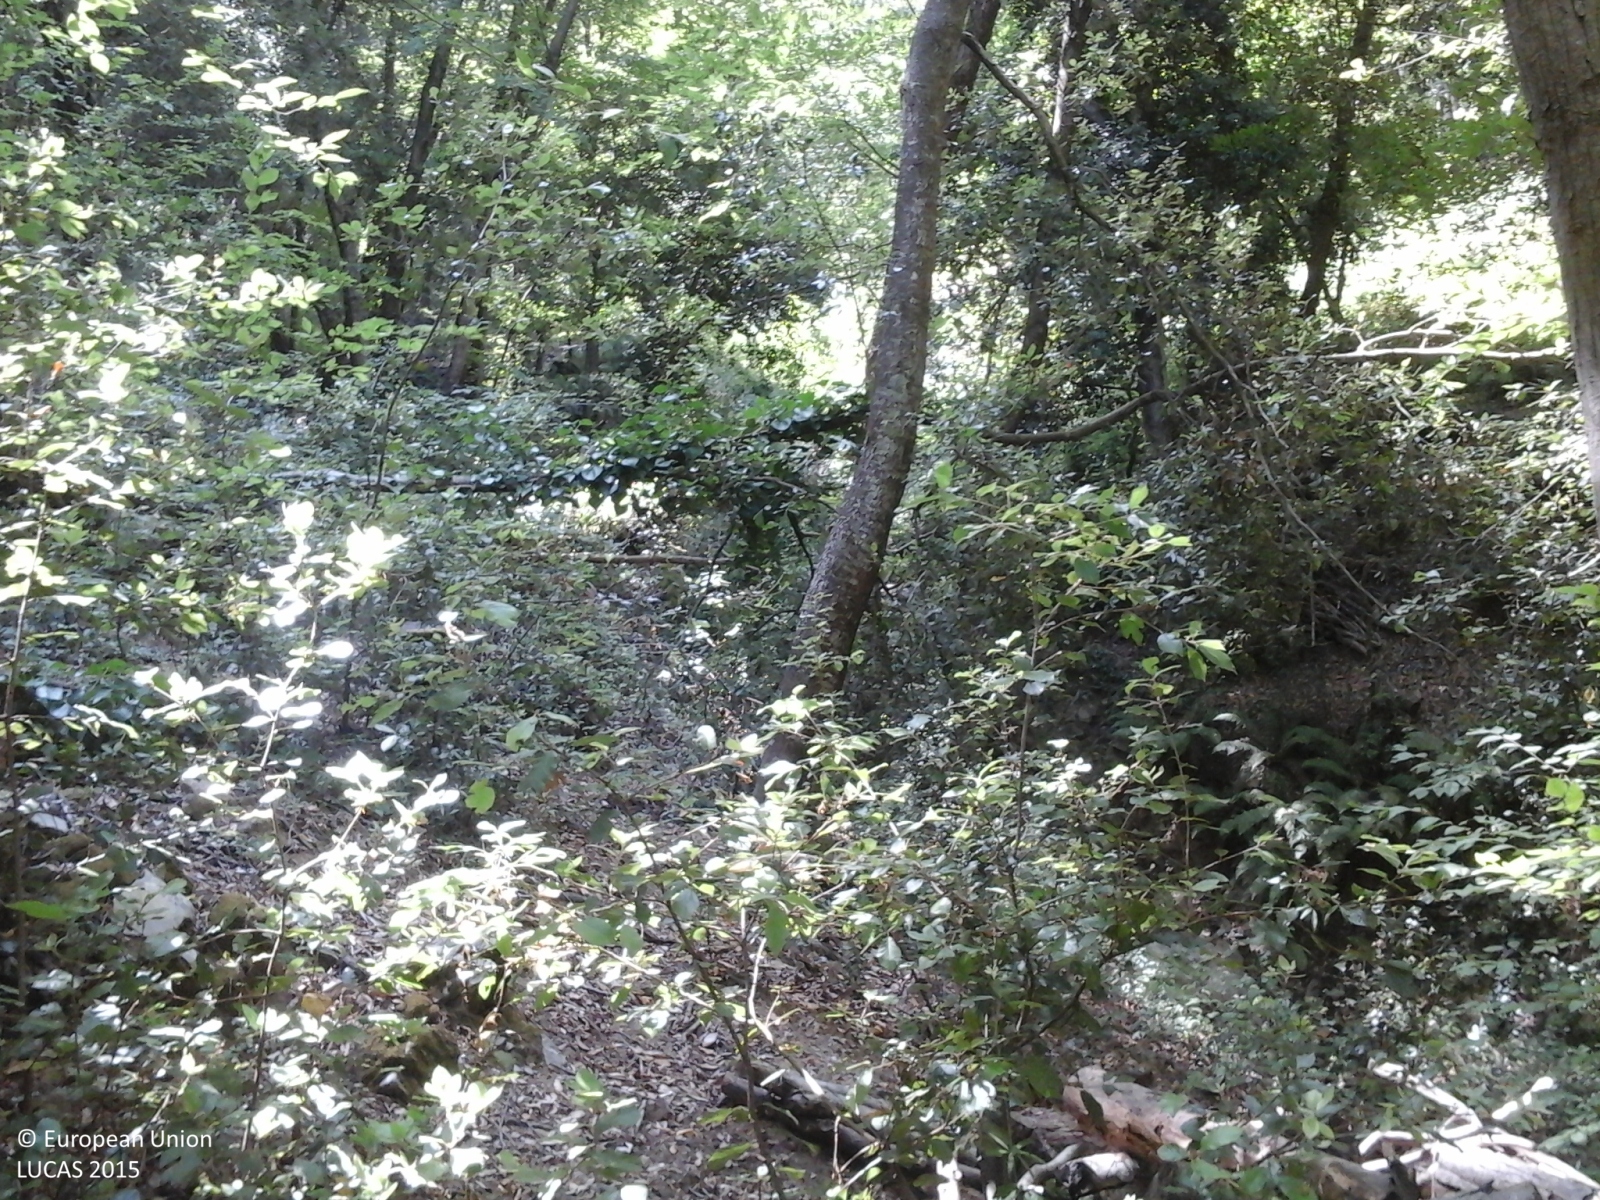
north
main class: Woodland
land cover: Other mixed woodland
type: broadleaved evergreen forest
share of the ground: > 75 %
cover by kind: broadleaved forest trees 75 %, coniferous forest trees 25 %
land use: Semi-natural and natural areas not in use
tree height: > 5 m
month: July
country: IT
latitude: 42.7801
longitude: 10.2802
